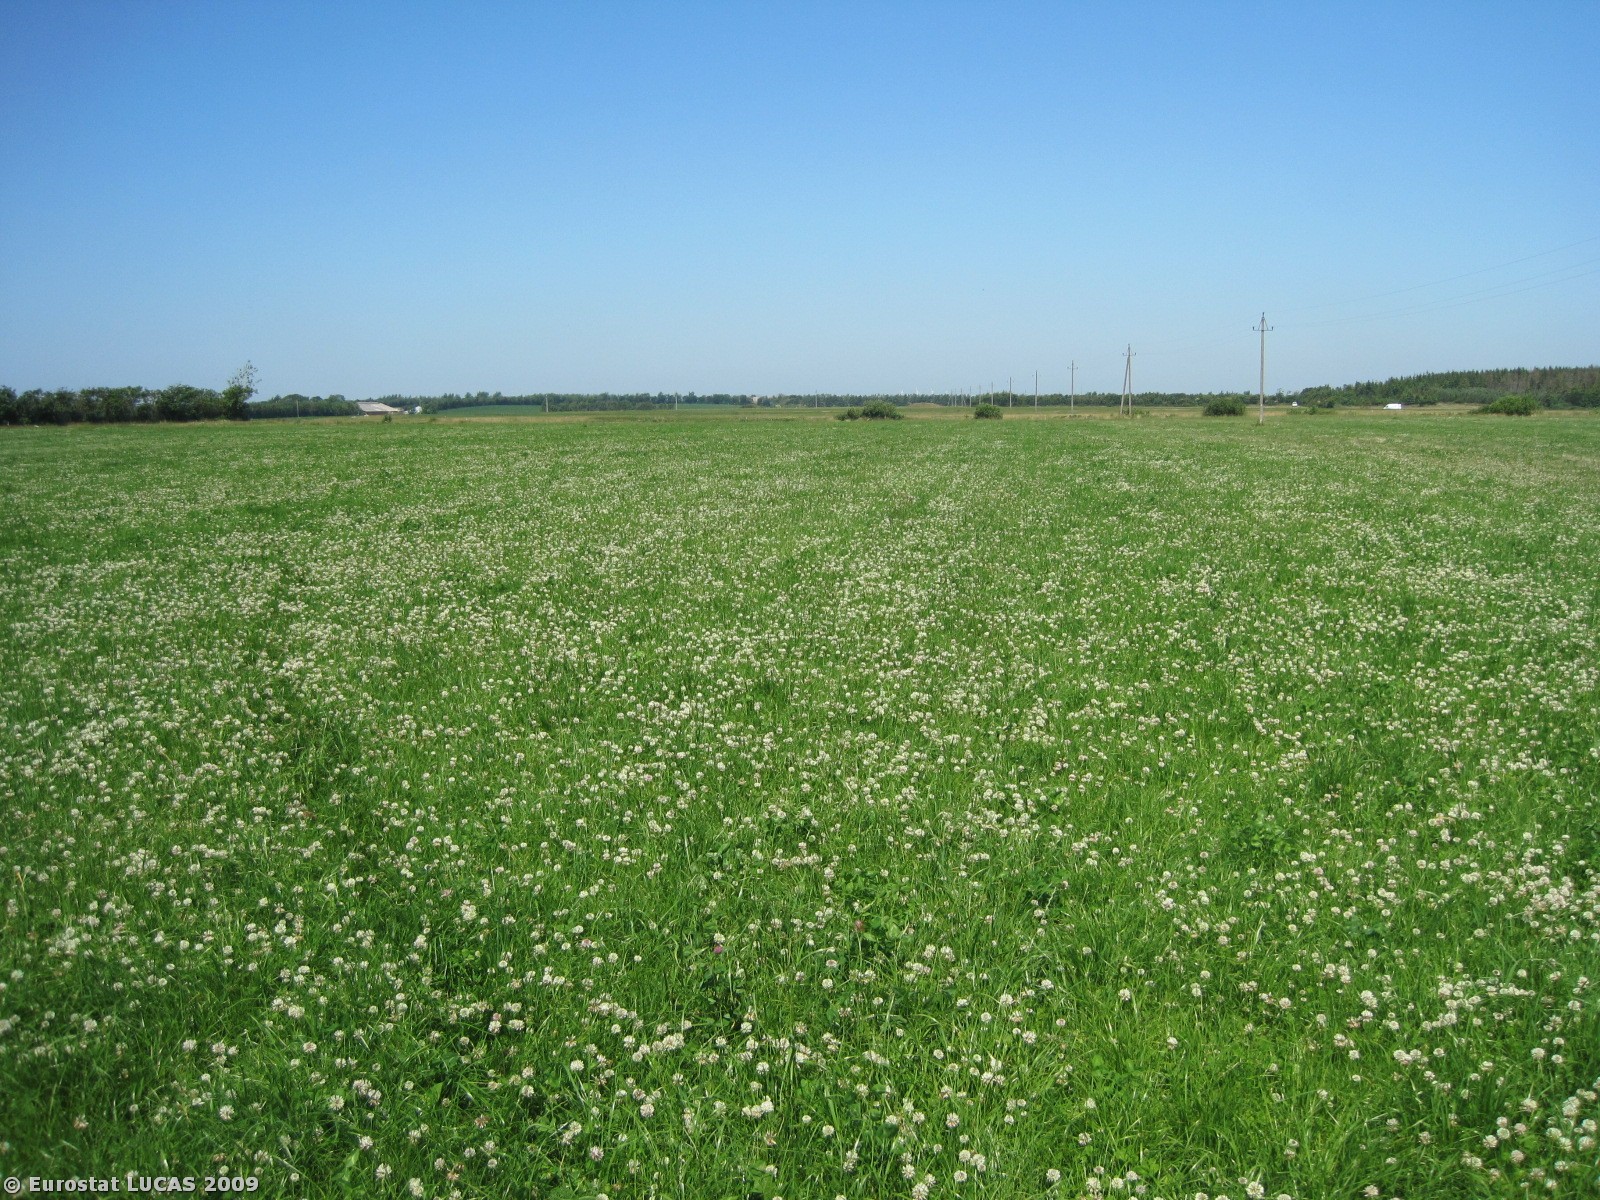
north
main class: Grassland
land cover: Grassland without tree/shrub cover
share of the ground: > 75 %
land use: Agriculture (excluding fallow land and kitchen gardens)
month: July
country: DK
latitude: 56.4637
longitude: 8.2655
